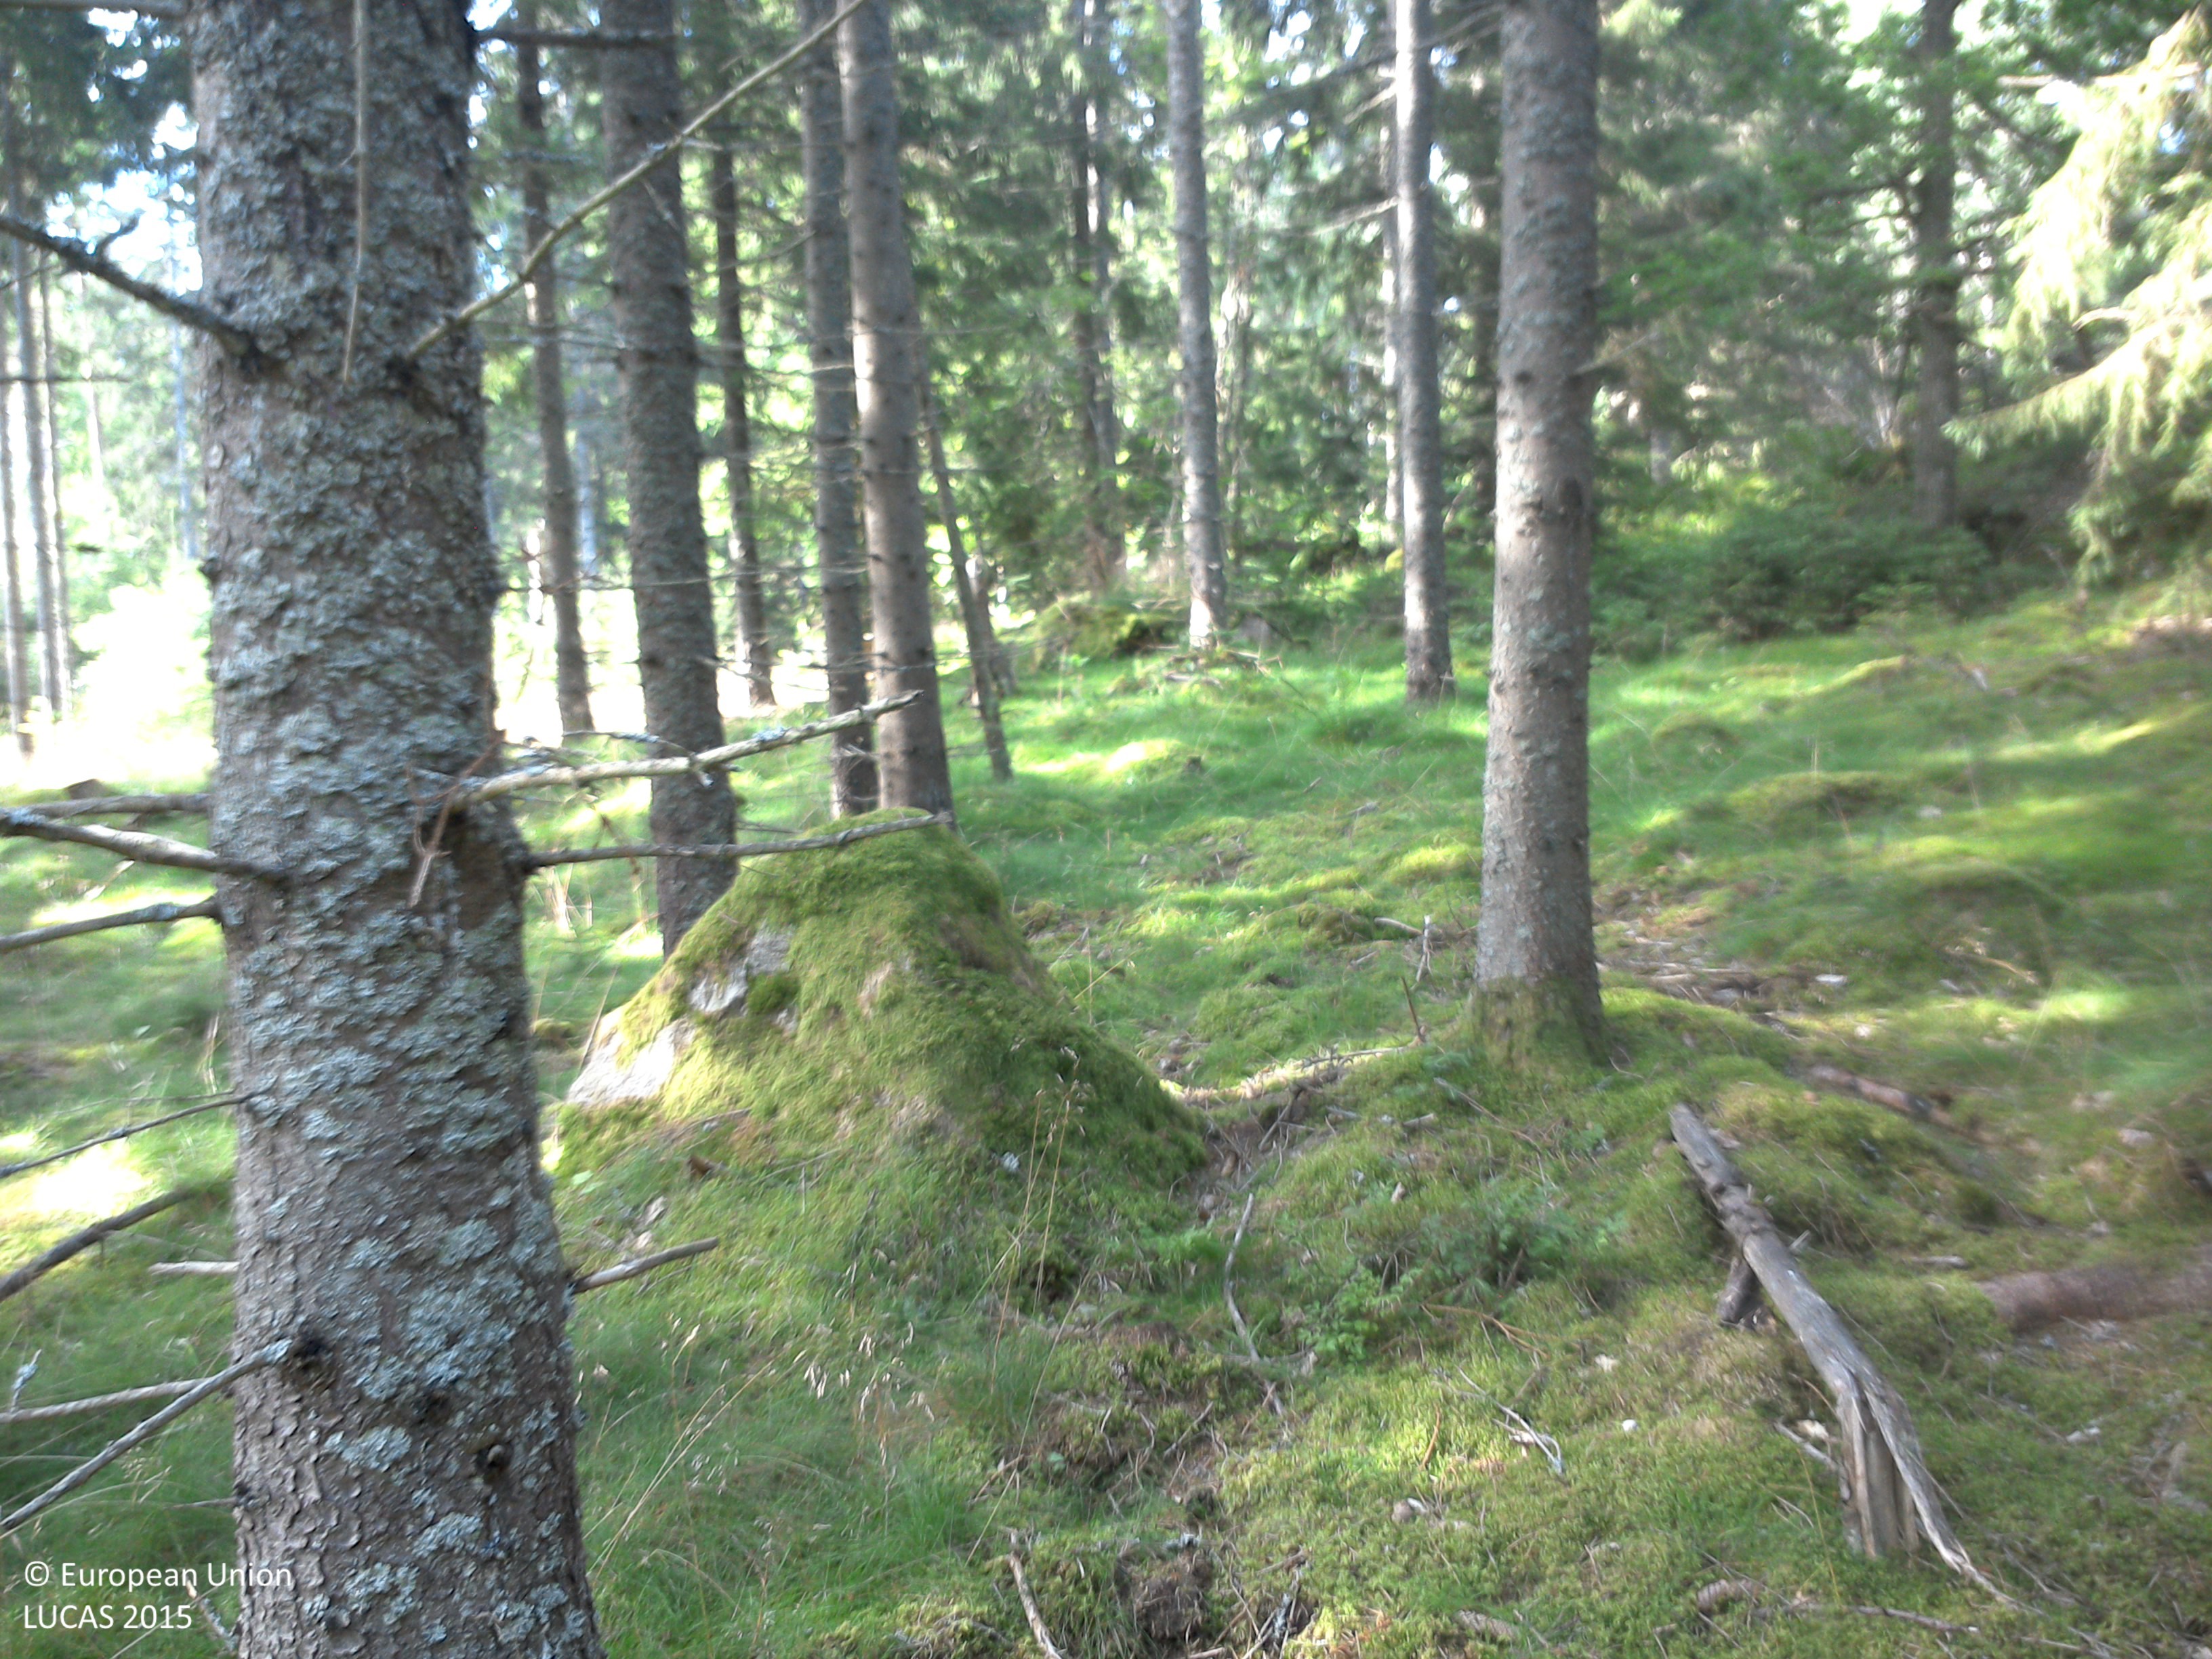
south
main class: Woodland
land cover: Spruce dominated coniferous woodland
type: boreal forest
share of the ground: 50 - 75 %
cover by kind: coniferous forest trees 55 %, lichens and mosses 45 %
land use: Forestry
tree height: > 5 m
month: August
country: SE
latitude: 58.2378
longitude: 14.9166
